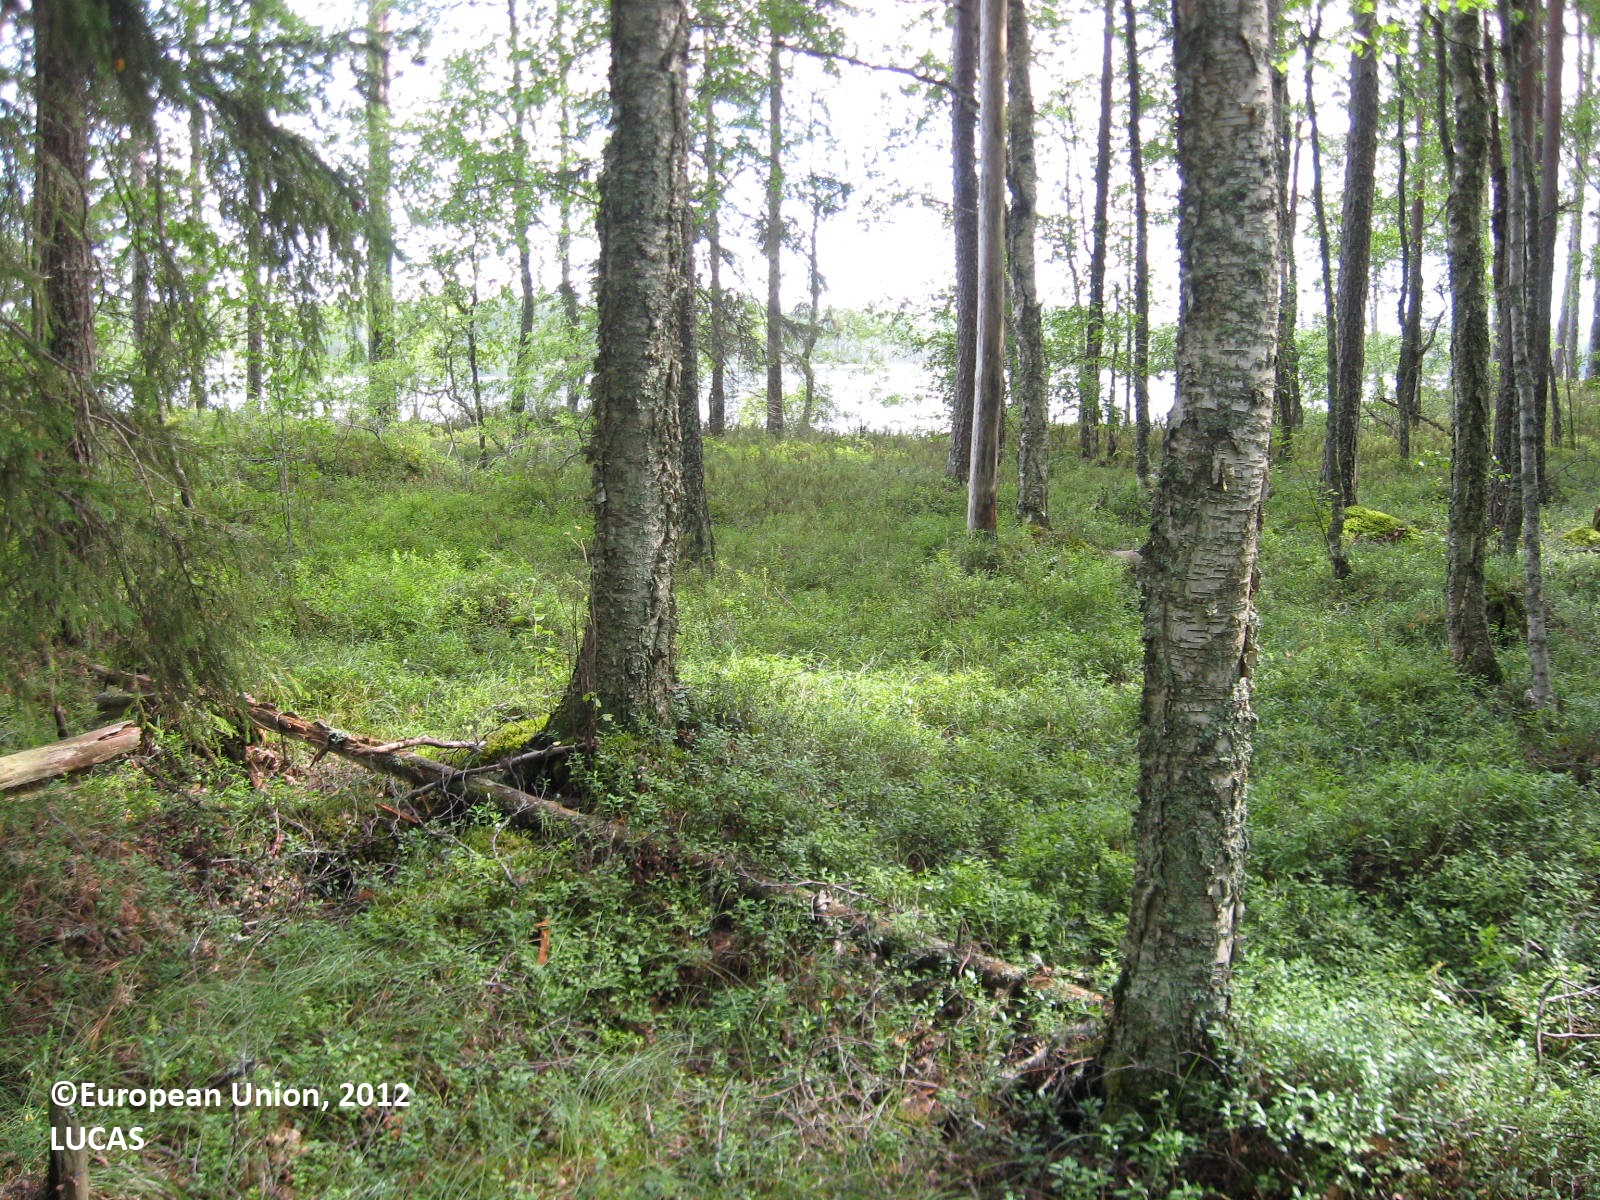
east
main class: Woodland
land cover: Other mixed woodland
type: boreal forest
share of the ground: > 75 %
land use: Forestry
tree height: > 5 m
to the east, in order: Other mixed woodland; Inland water bodies
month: July
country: FI
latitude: 62.0821
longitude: 22.7950
